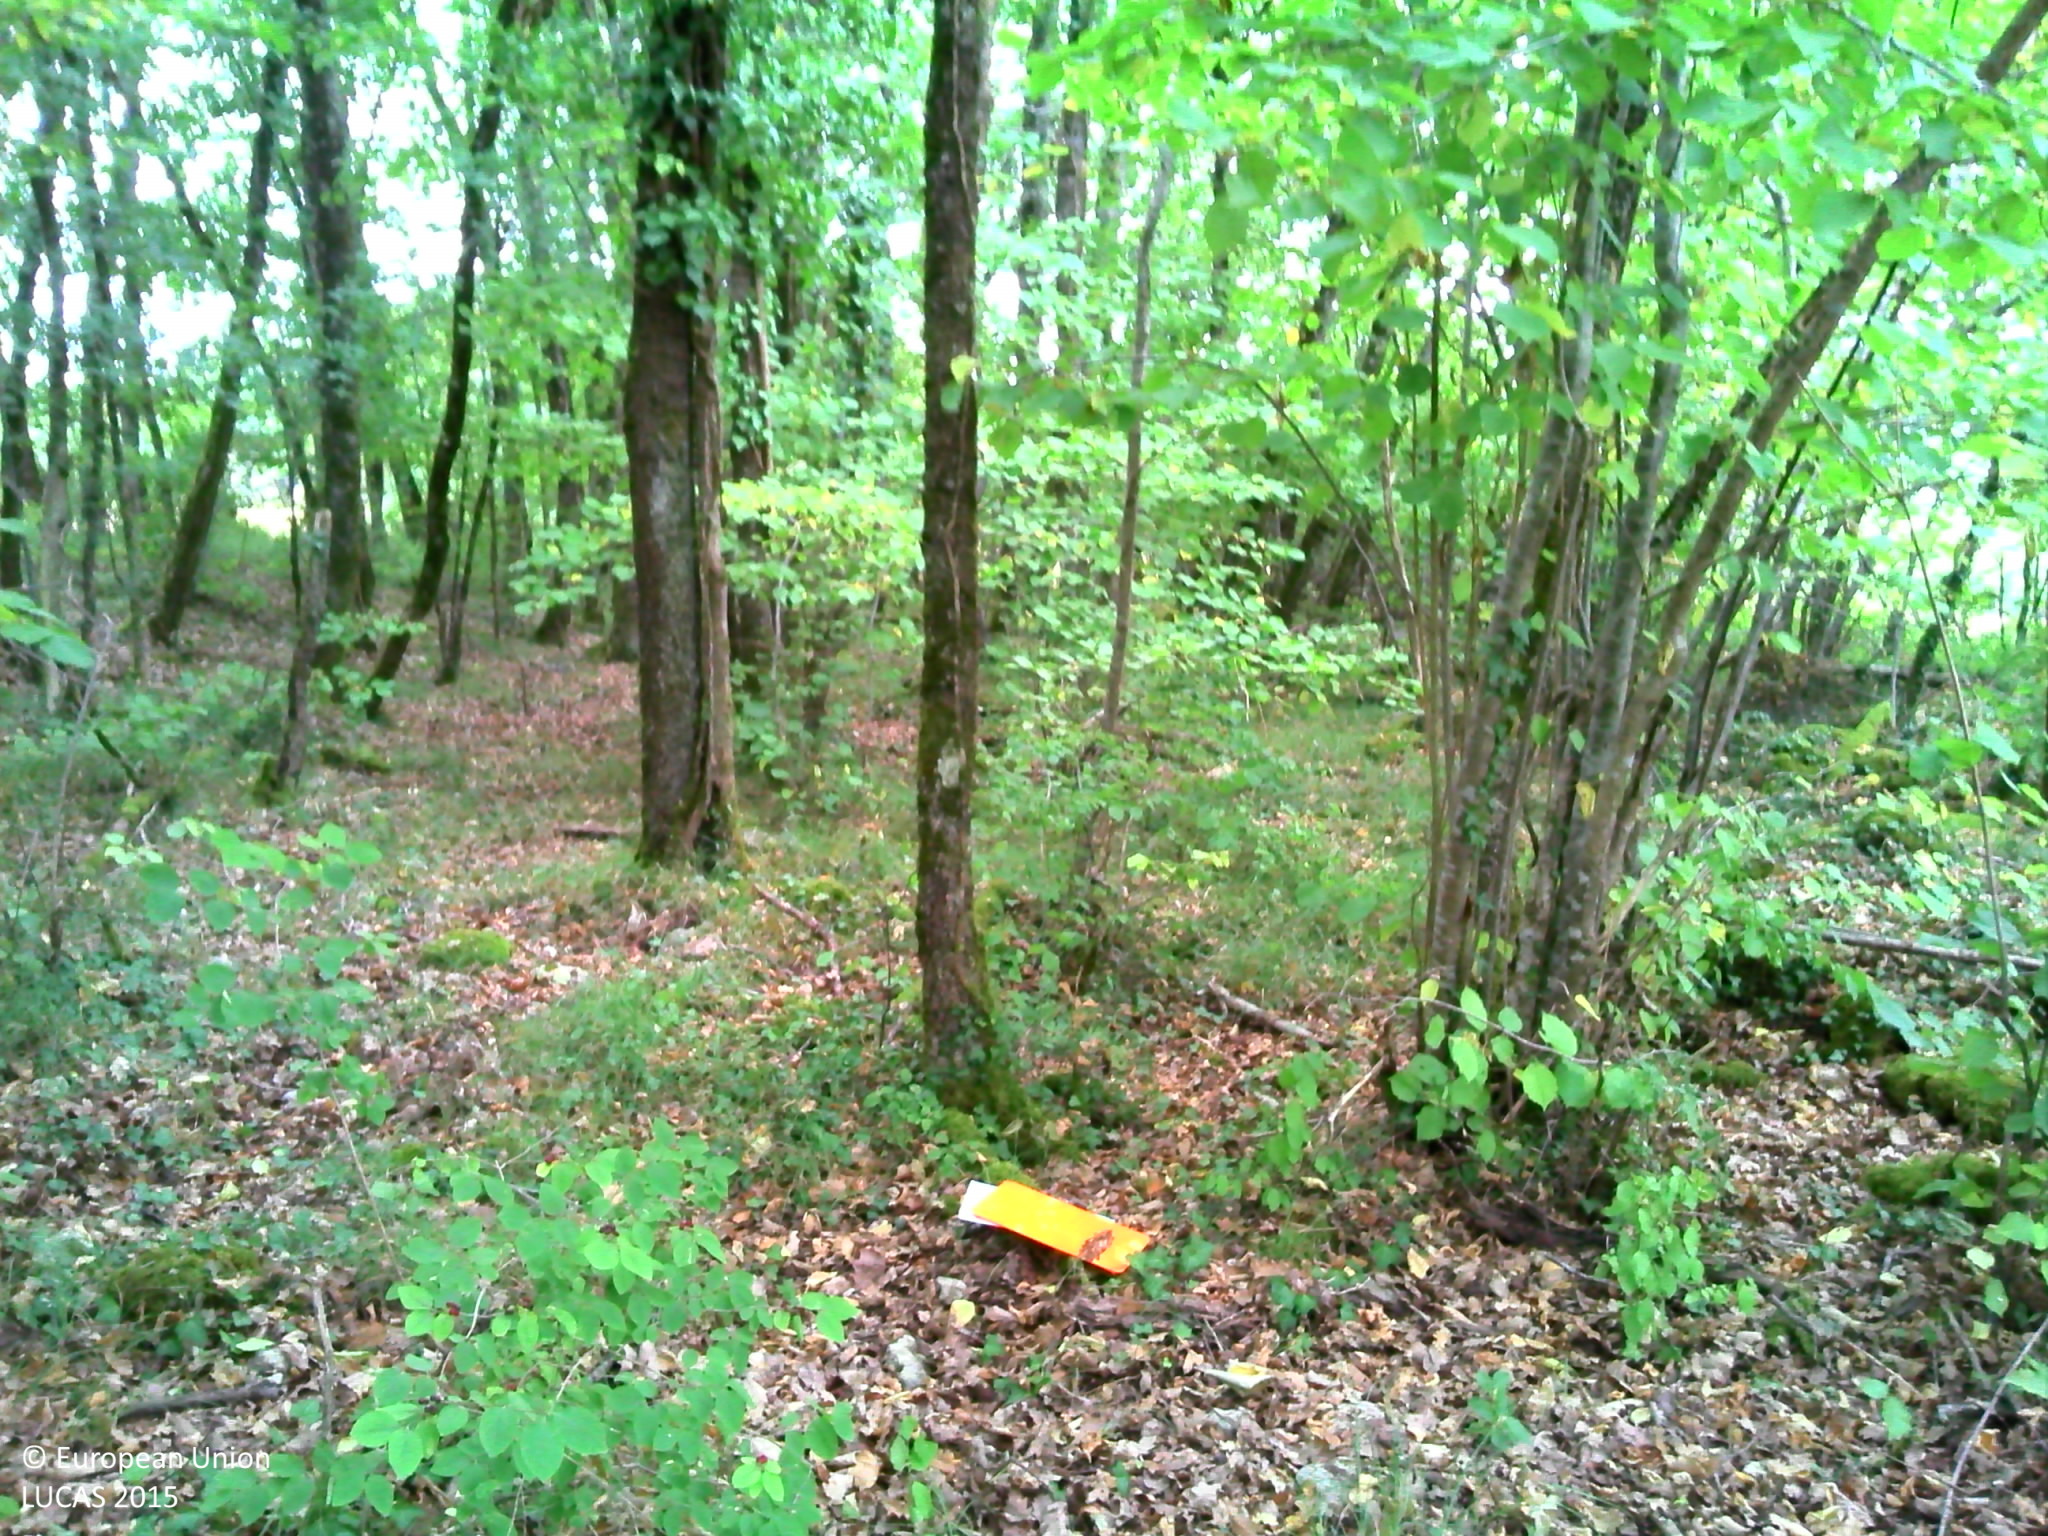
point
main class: Woodland
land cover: Broadleaved woodland
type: acidophilous oak and oak-birch forest
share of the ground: > 75 %
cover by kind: broadleaved forest trees 80 %, herbaceous plants 10 %, shrubs 5 %, lichens and mosses 5 %
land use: Forestry
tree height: > 5 m
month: July
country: FR
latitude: 44.9526
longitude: 0.7511
